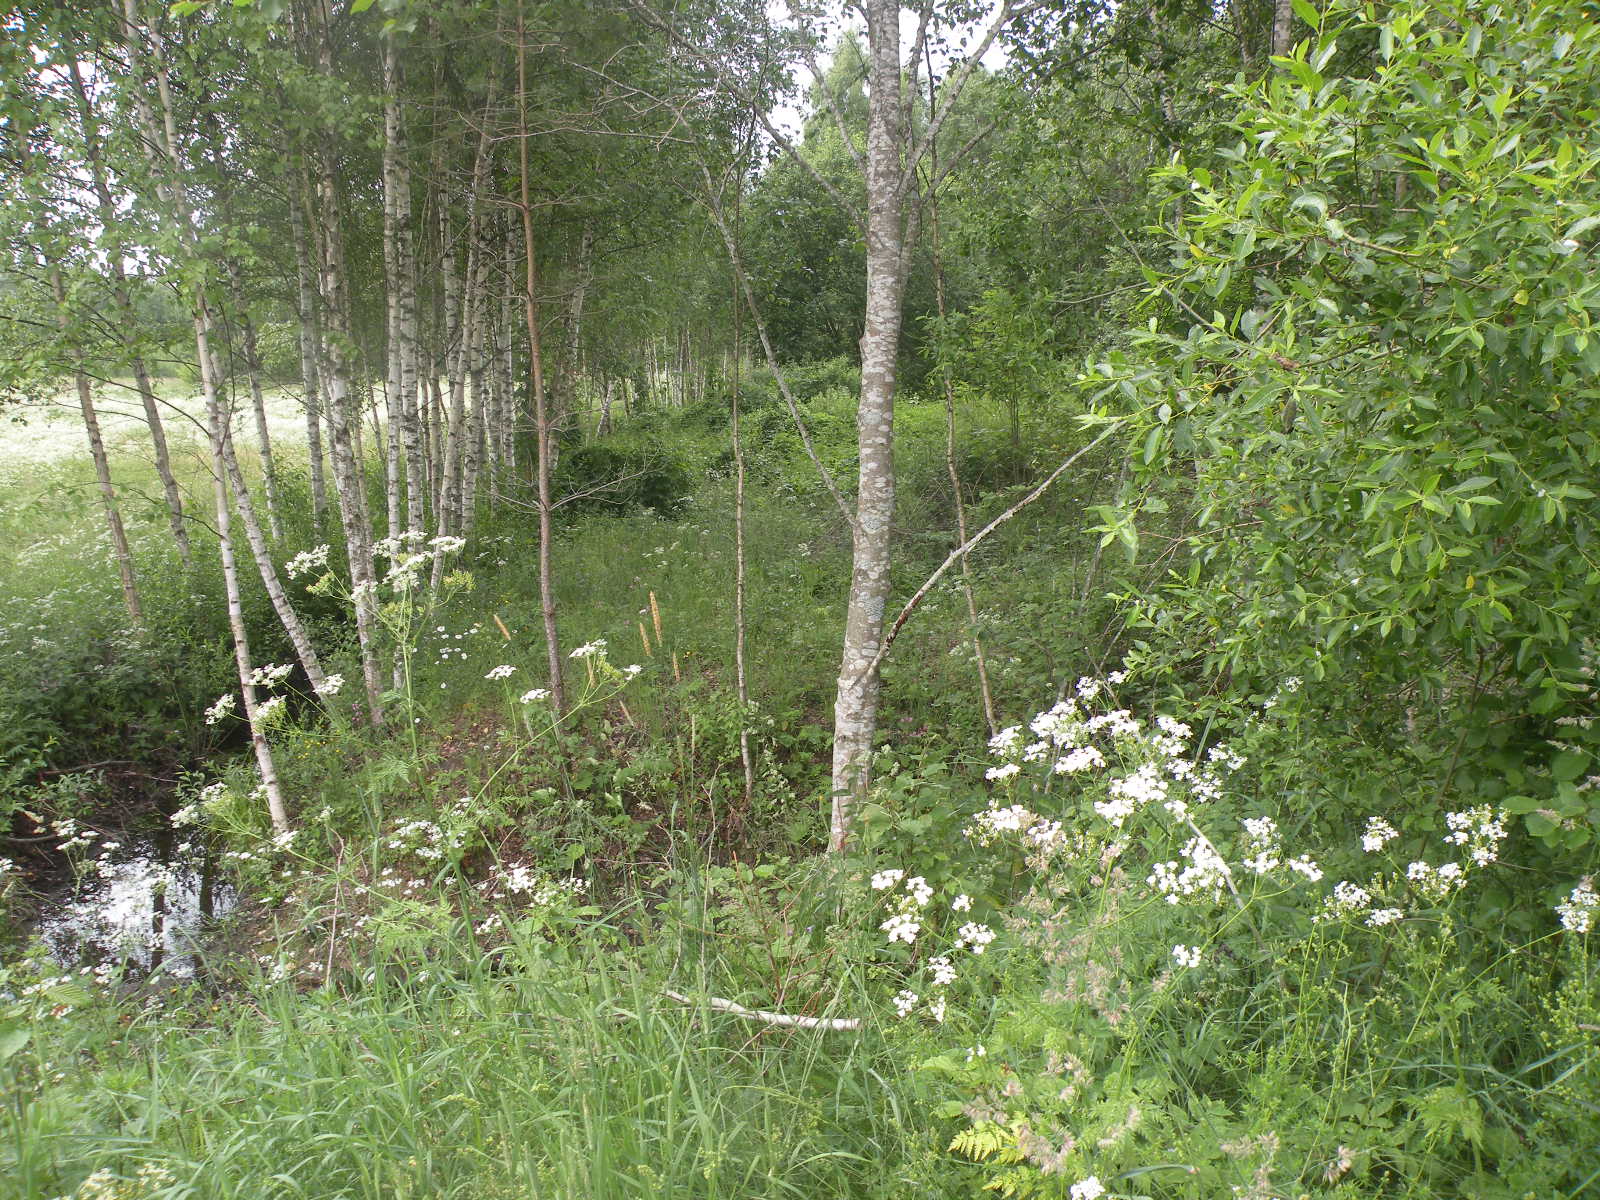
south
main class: Cropland
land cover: Rape and turnip rape
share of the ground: 10 - 25 %
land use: Agriculture (excluding fallow land and kitchen gardens)
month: June
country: LV
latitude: 55.9401
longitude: 27.0249
